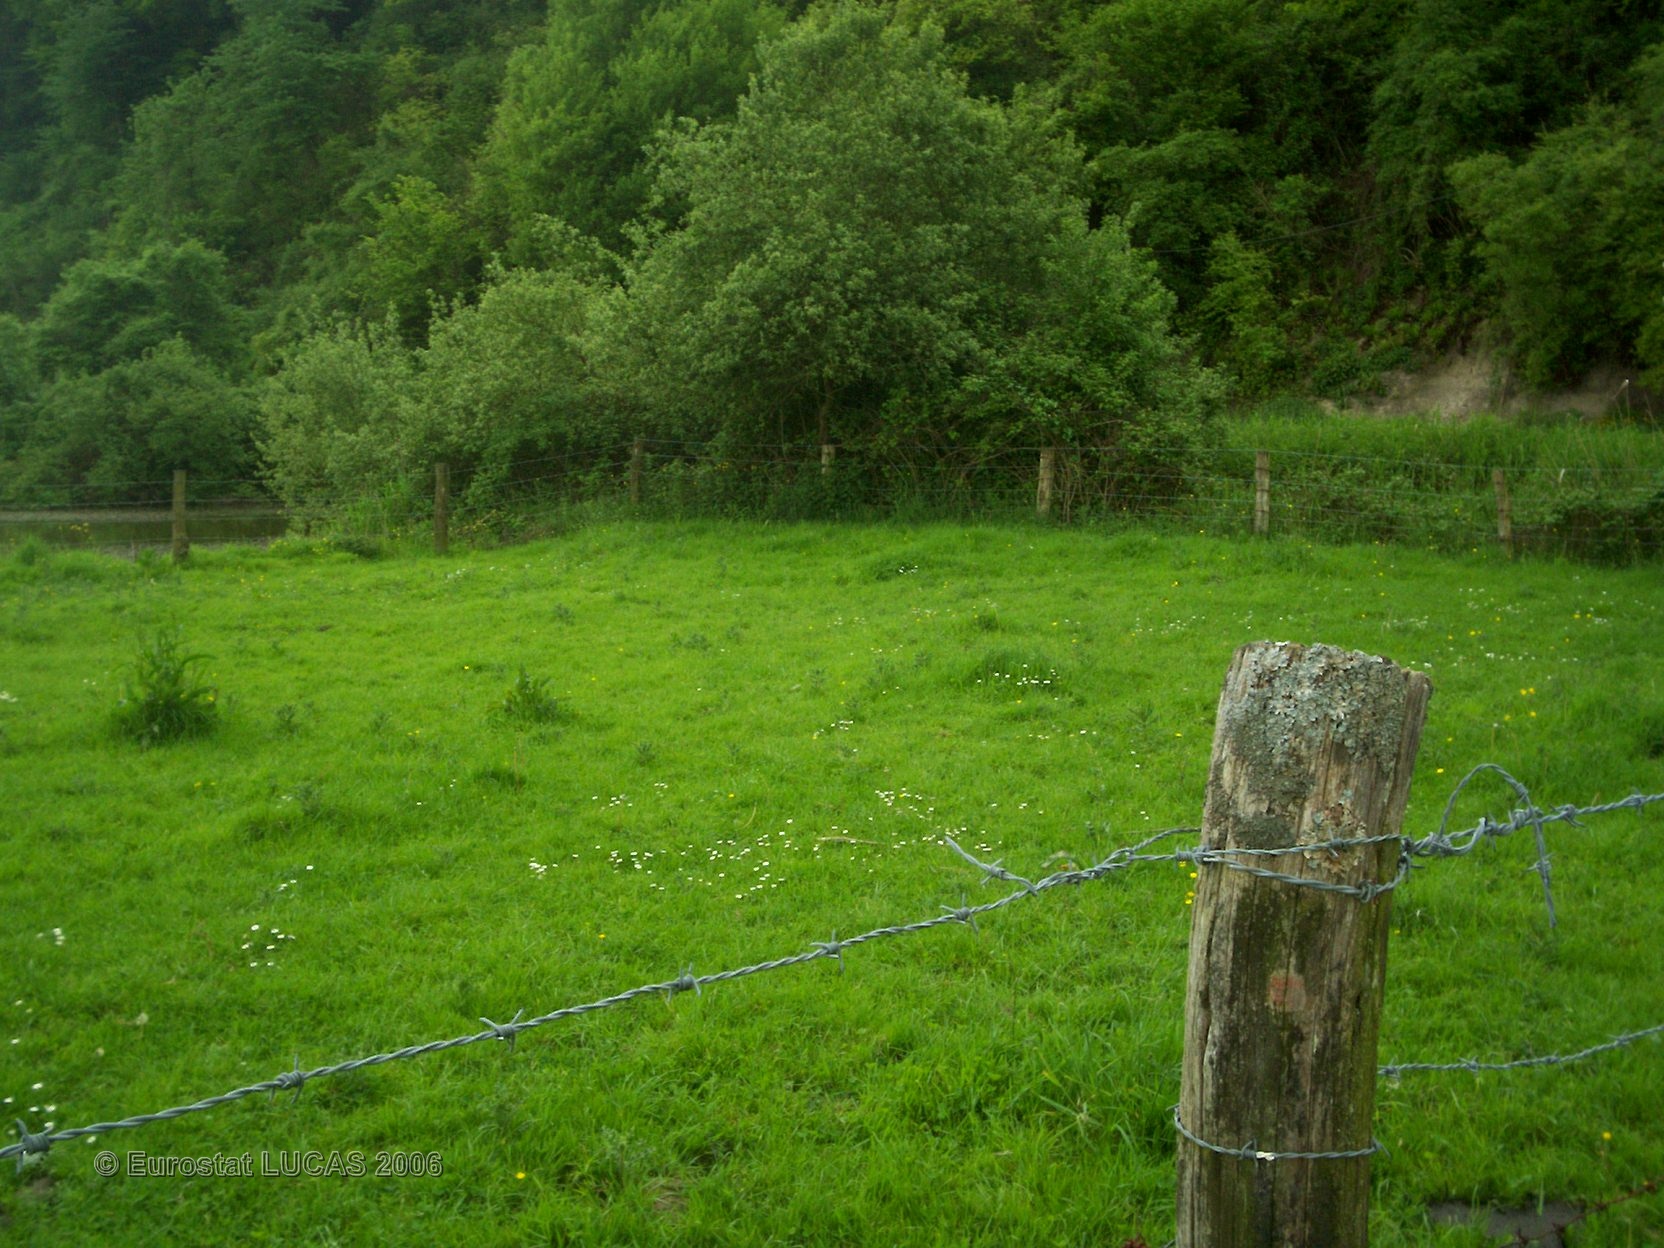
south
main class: Grassland
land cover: Grassland without tree/shrub cover
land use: Agriculture (excluding fallow land and kitchen gardens)
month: May
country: FR
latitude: 49.4379
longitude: 0.4437
